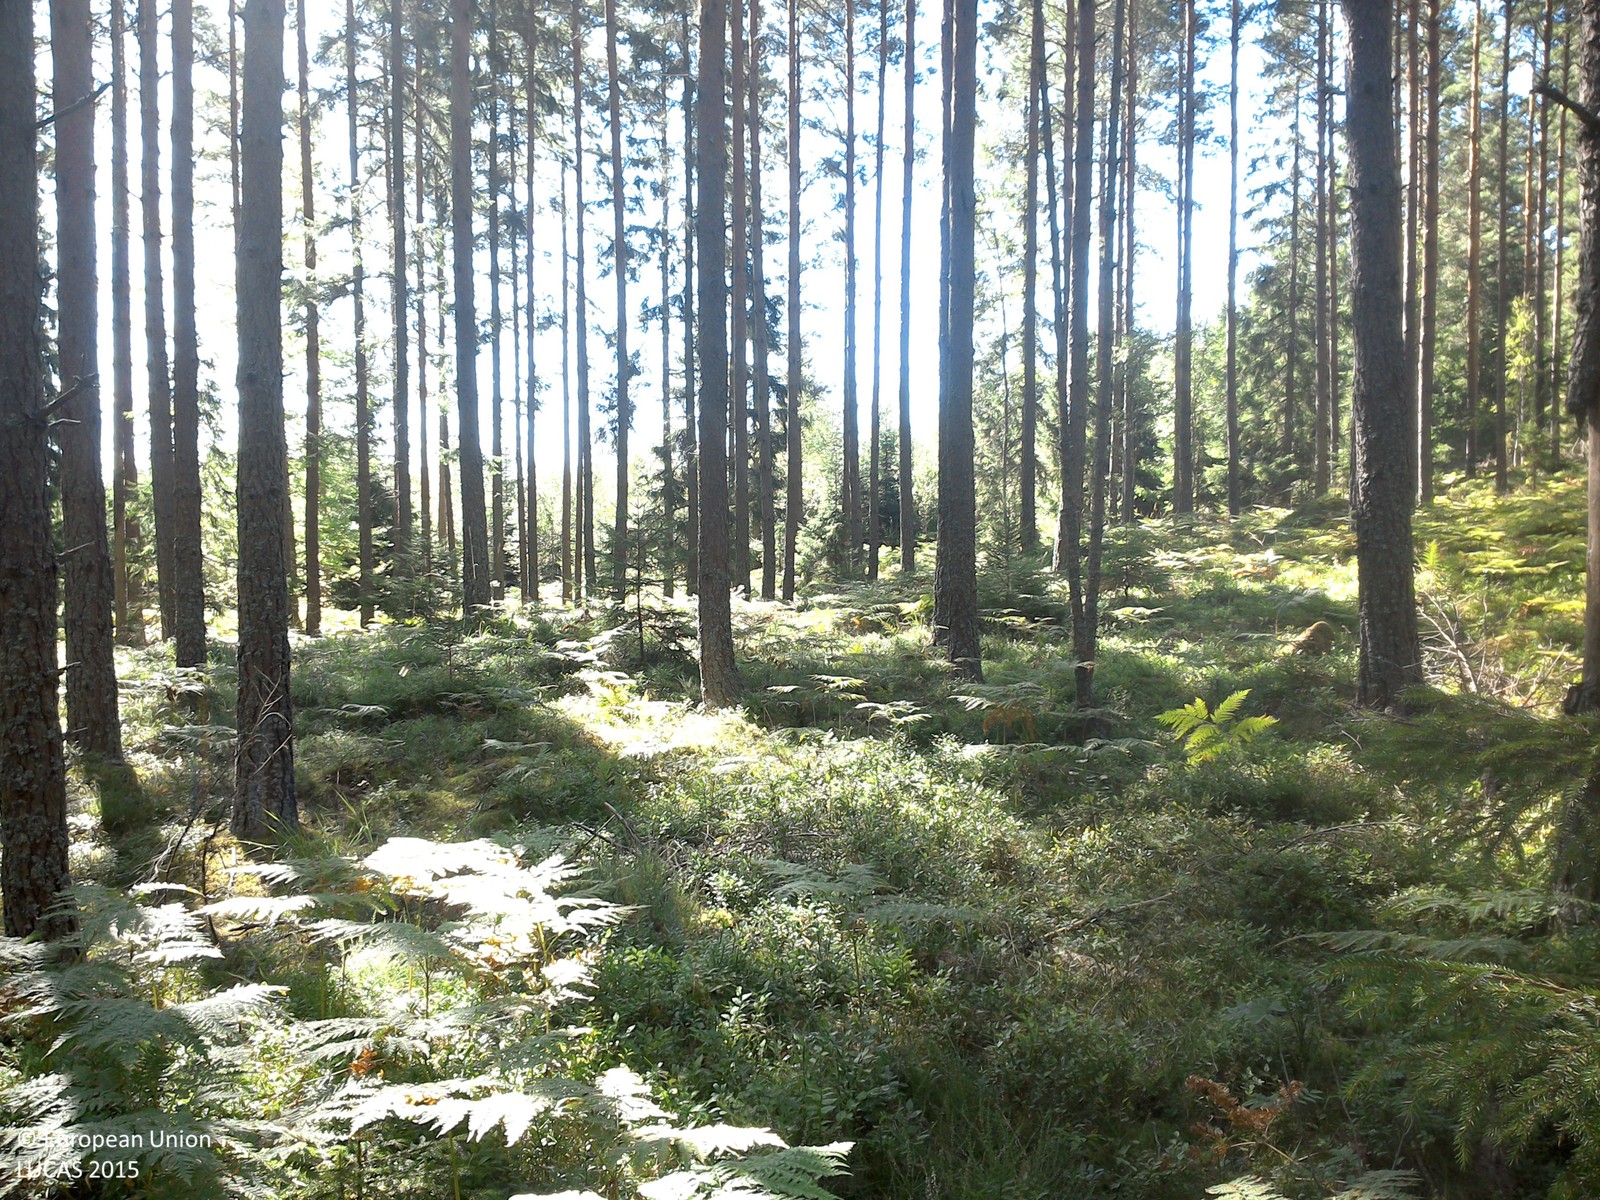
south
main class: Woodland
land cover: Pine dominated coniferous woodland
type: boreal forest
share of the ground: 25 - 50 %
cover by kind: coniferous forest trees 40 %, herbaceous plants 40 %, lichens and mosses 20 %
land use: Forestry
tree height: > 5 m
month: August
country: SE
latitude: 57.8777
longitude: 15.3746
